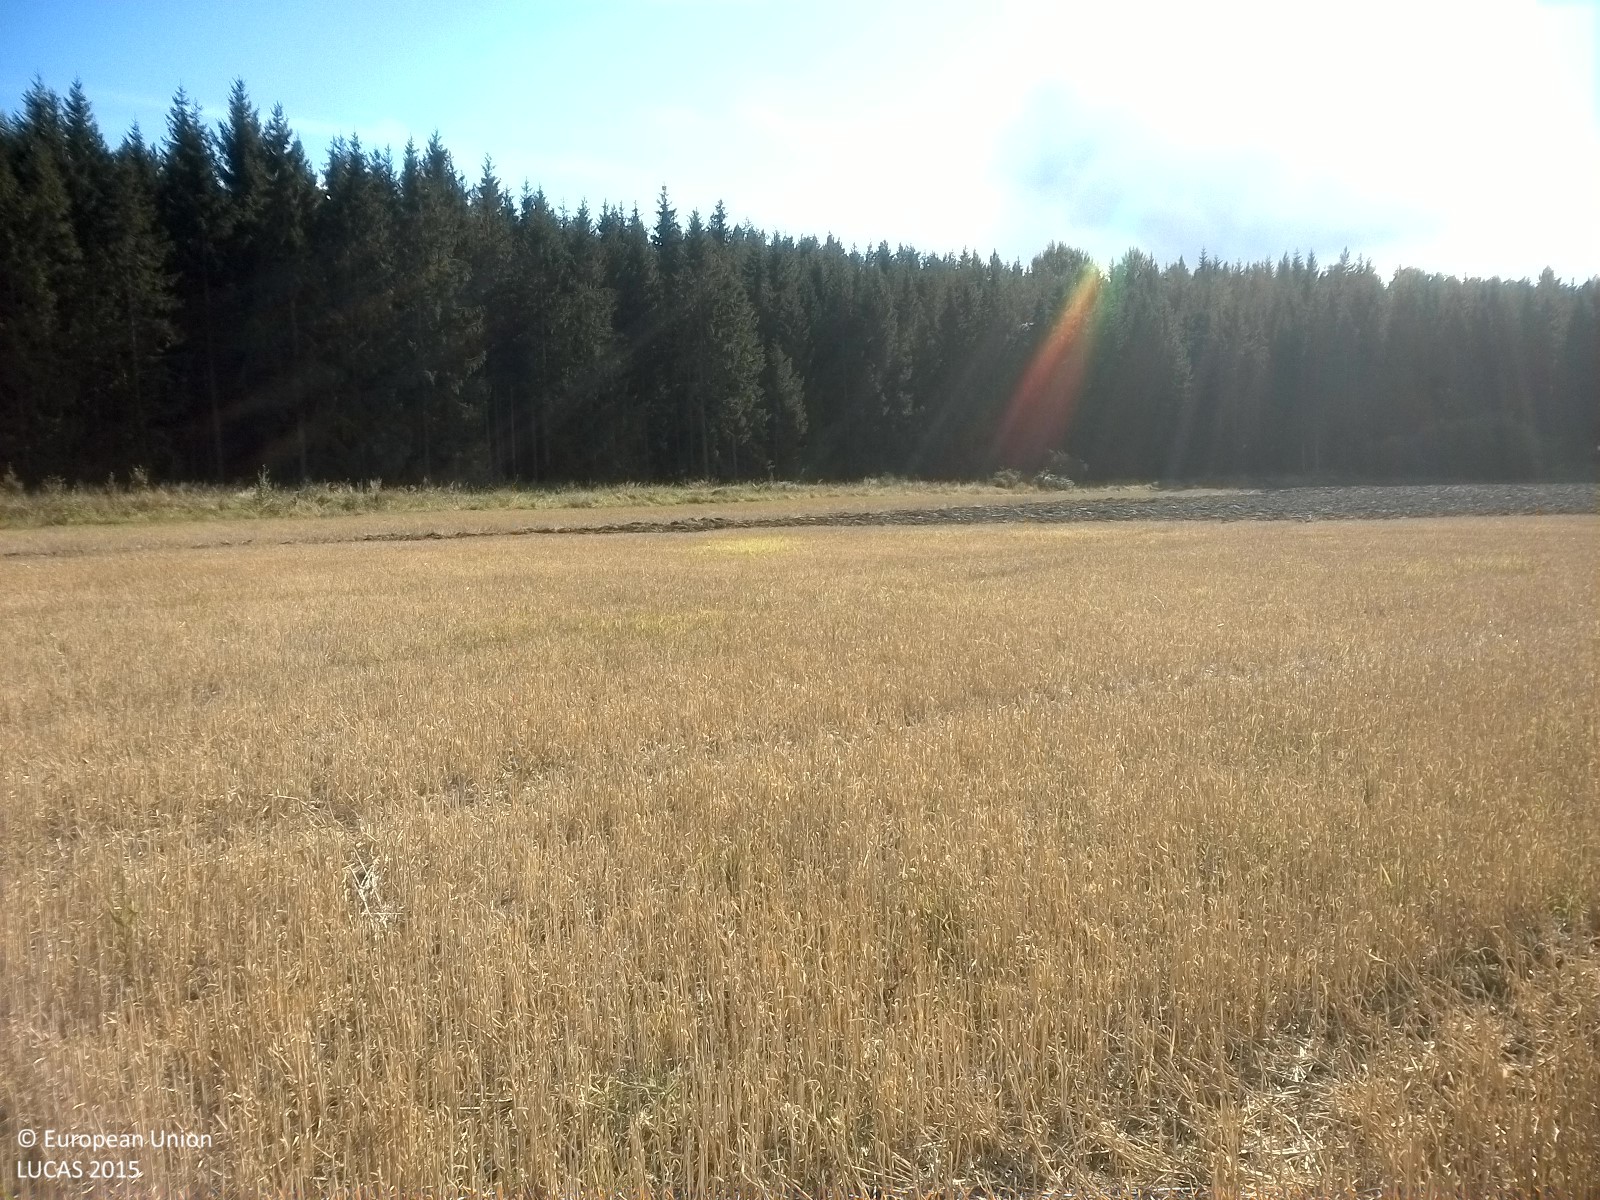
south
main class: Cropland
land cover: Common wheat
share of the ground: > 75 %
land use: Agriculture (excluding fallow land and kitchen gardens)
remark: Harvested field
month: September
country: SE
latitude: 58.4826
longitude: 16.3931
